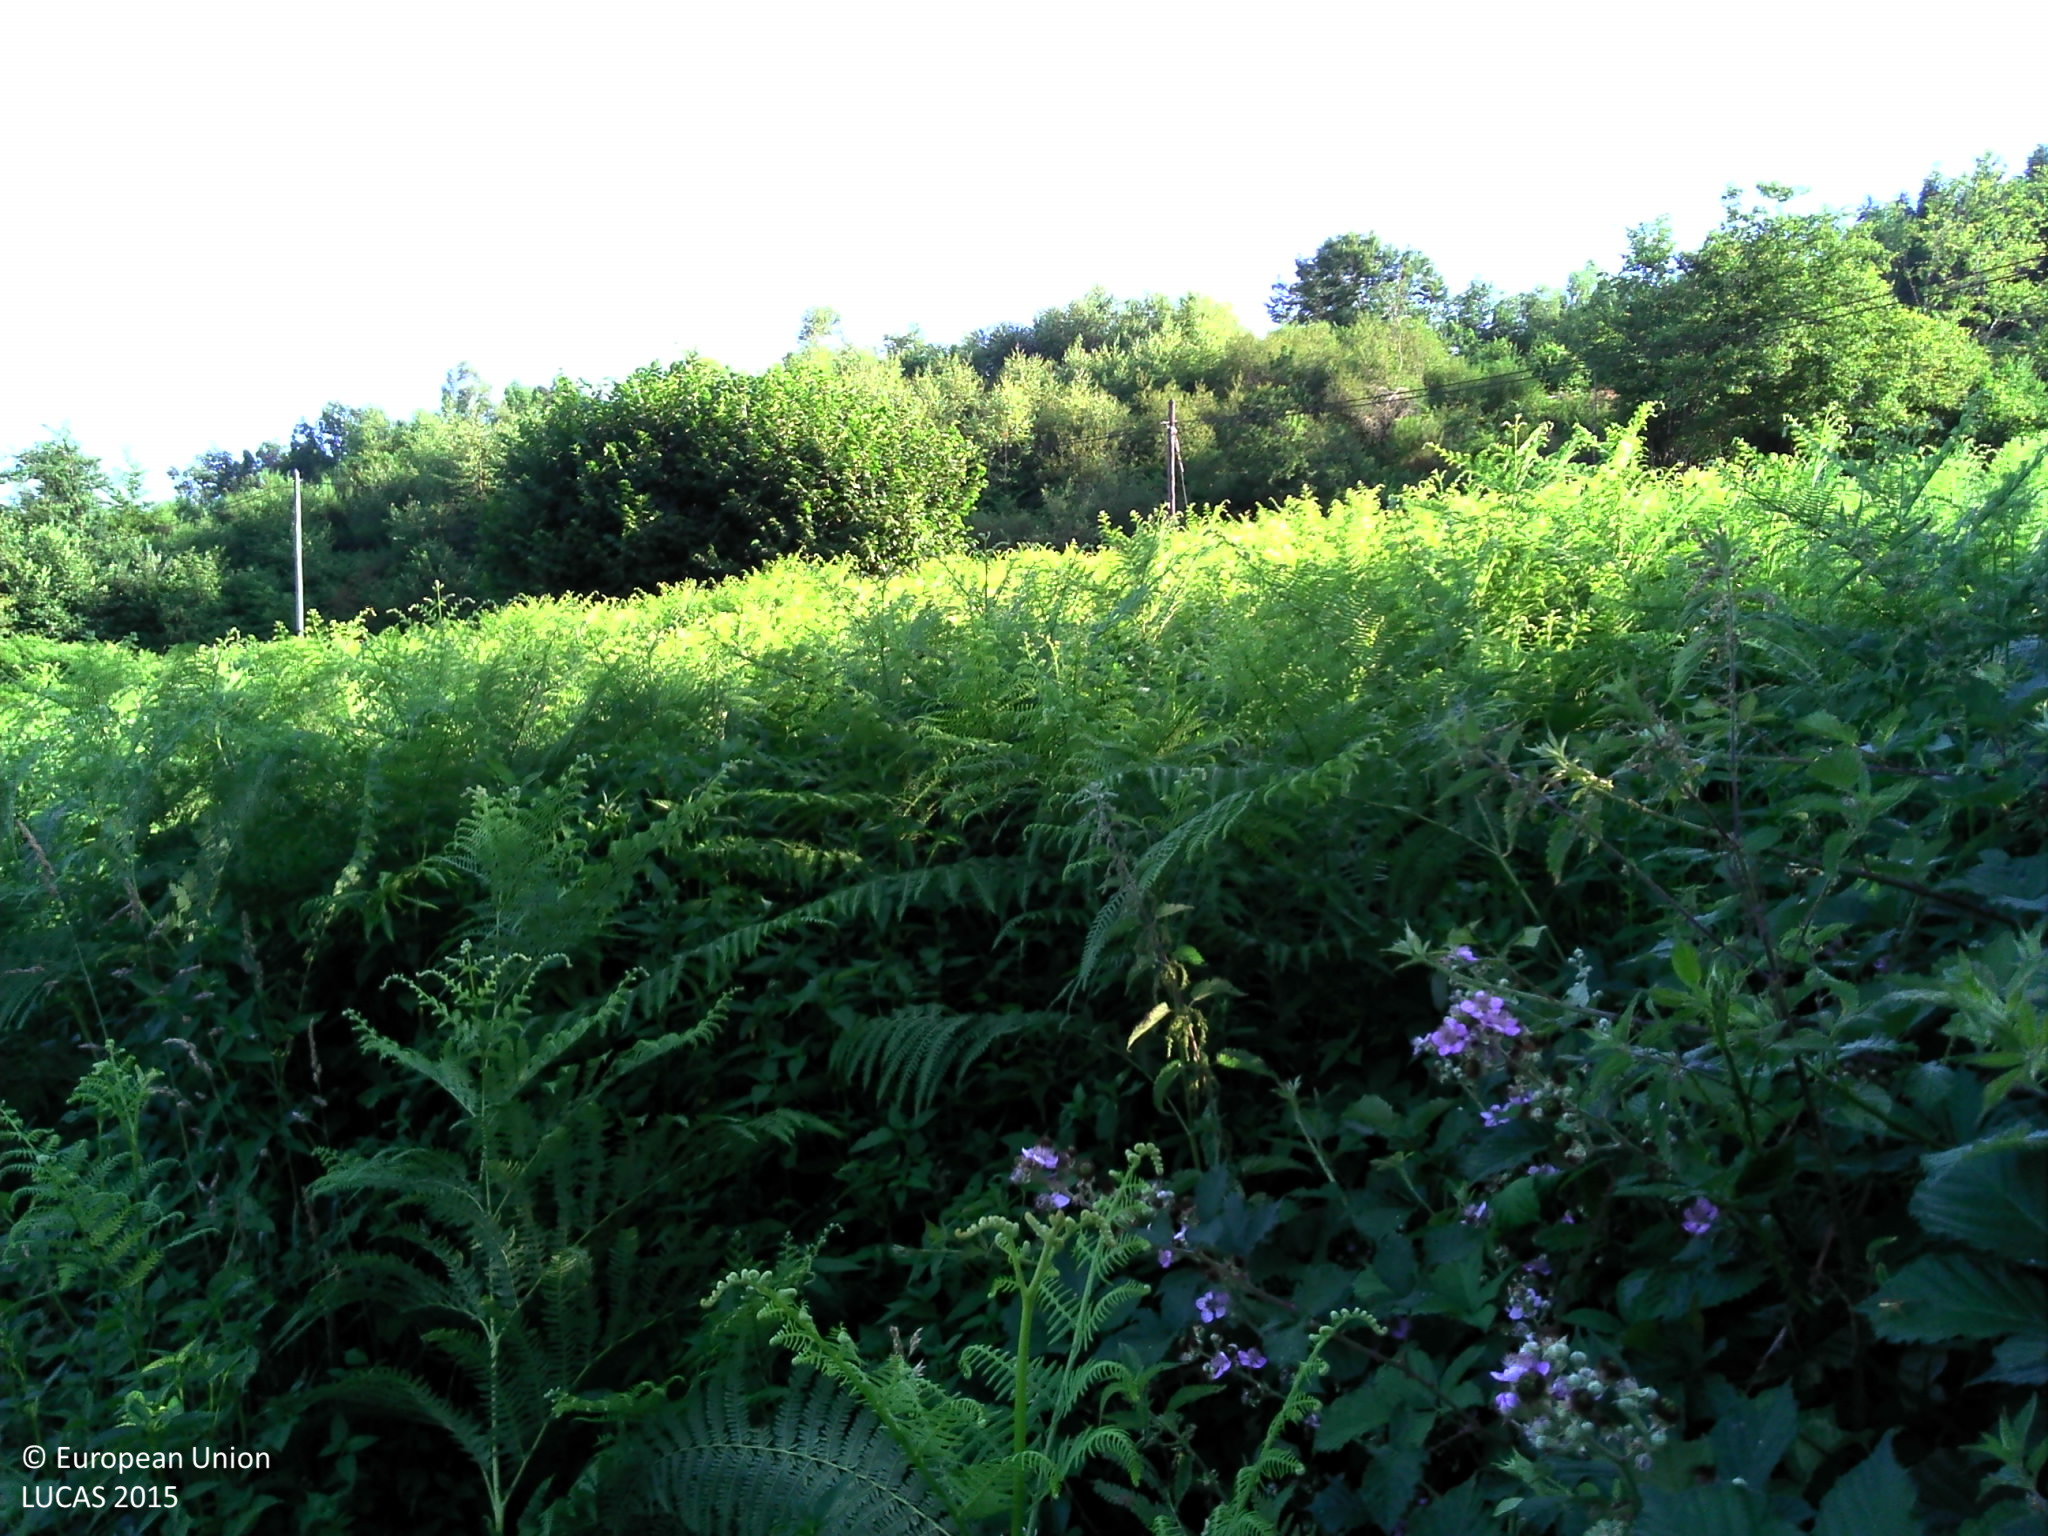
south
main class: Grassland
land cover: Spontaneously vegetated surfaces
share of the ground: > 75 %
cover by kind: herbaceous plants 95 %
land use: Agriculture (excluding fallow land and kitchen gardens)
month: July
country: FR
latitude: 45.6951
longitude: 1.8400
